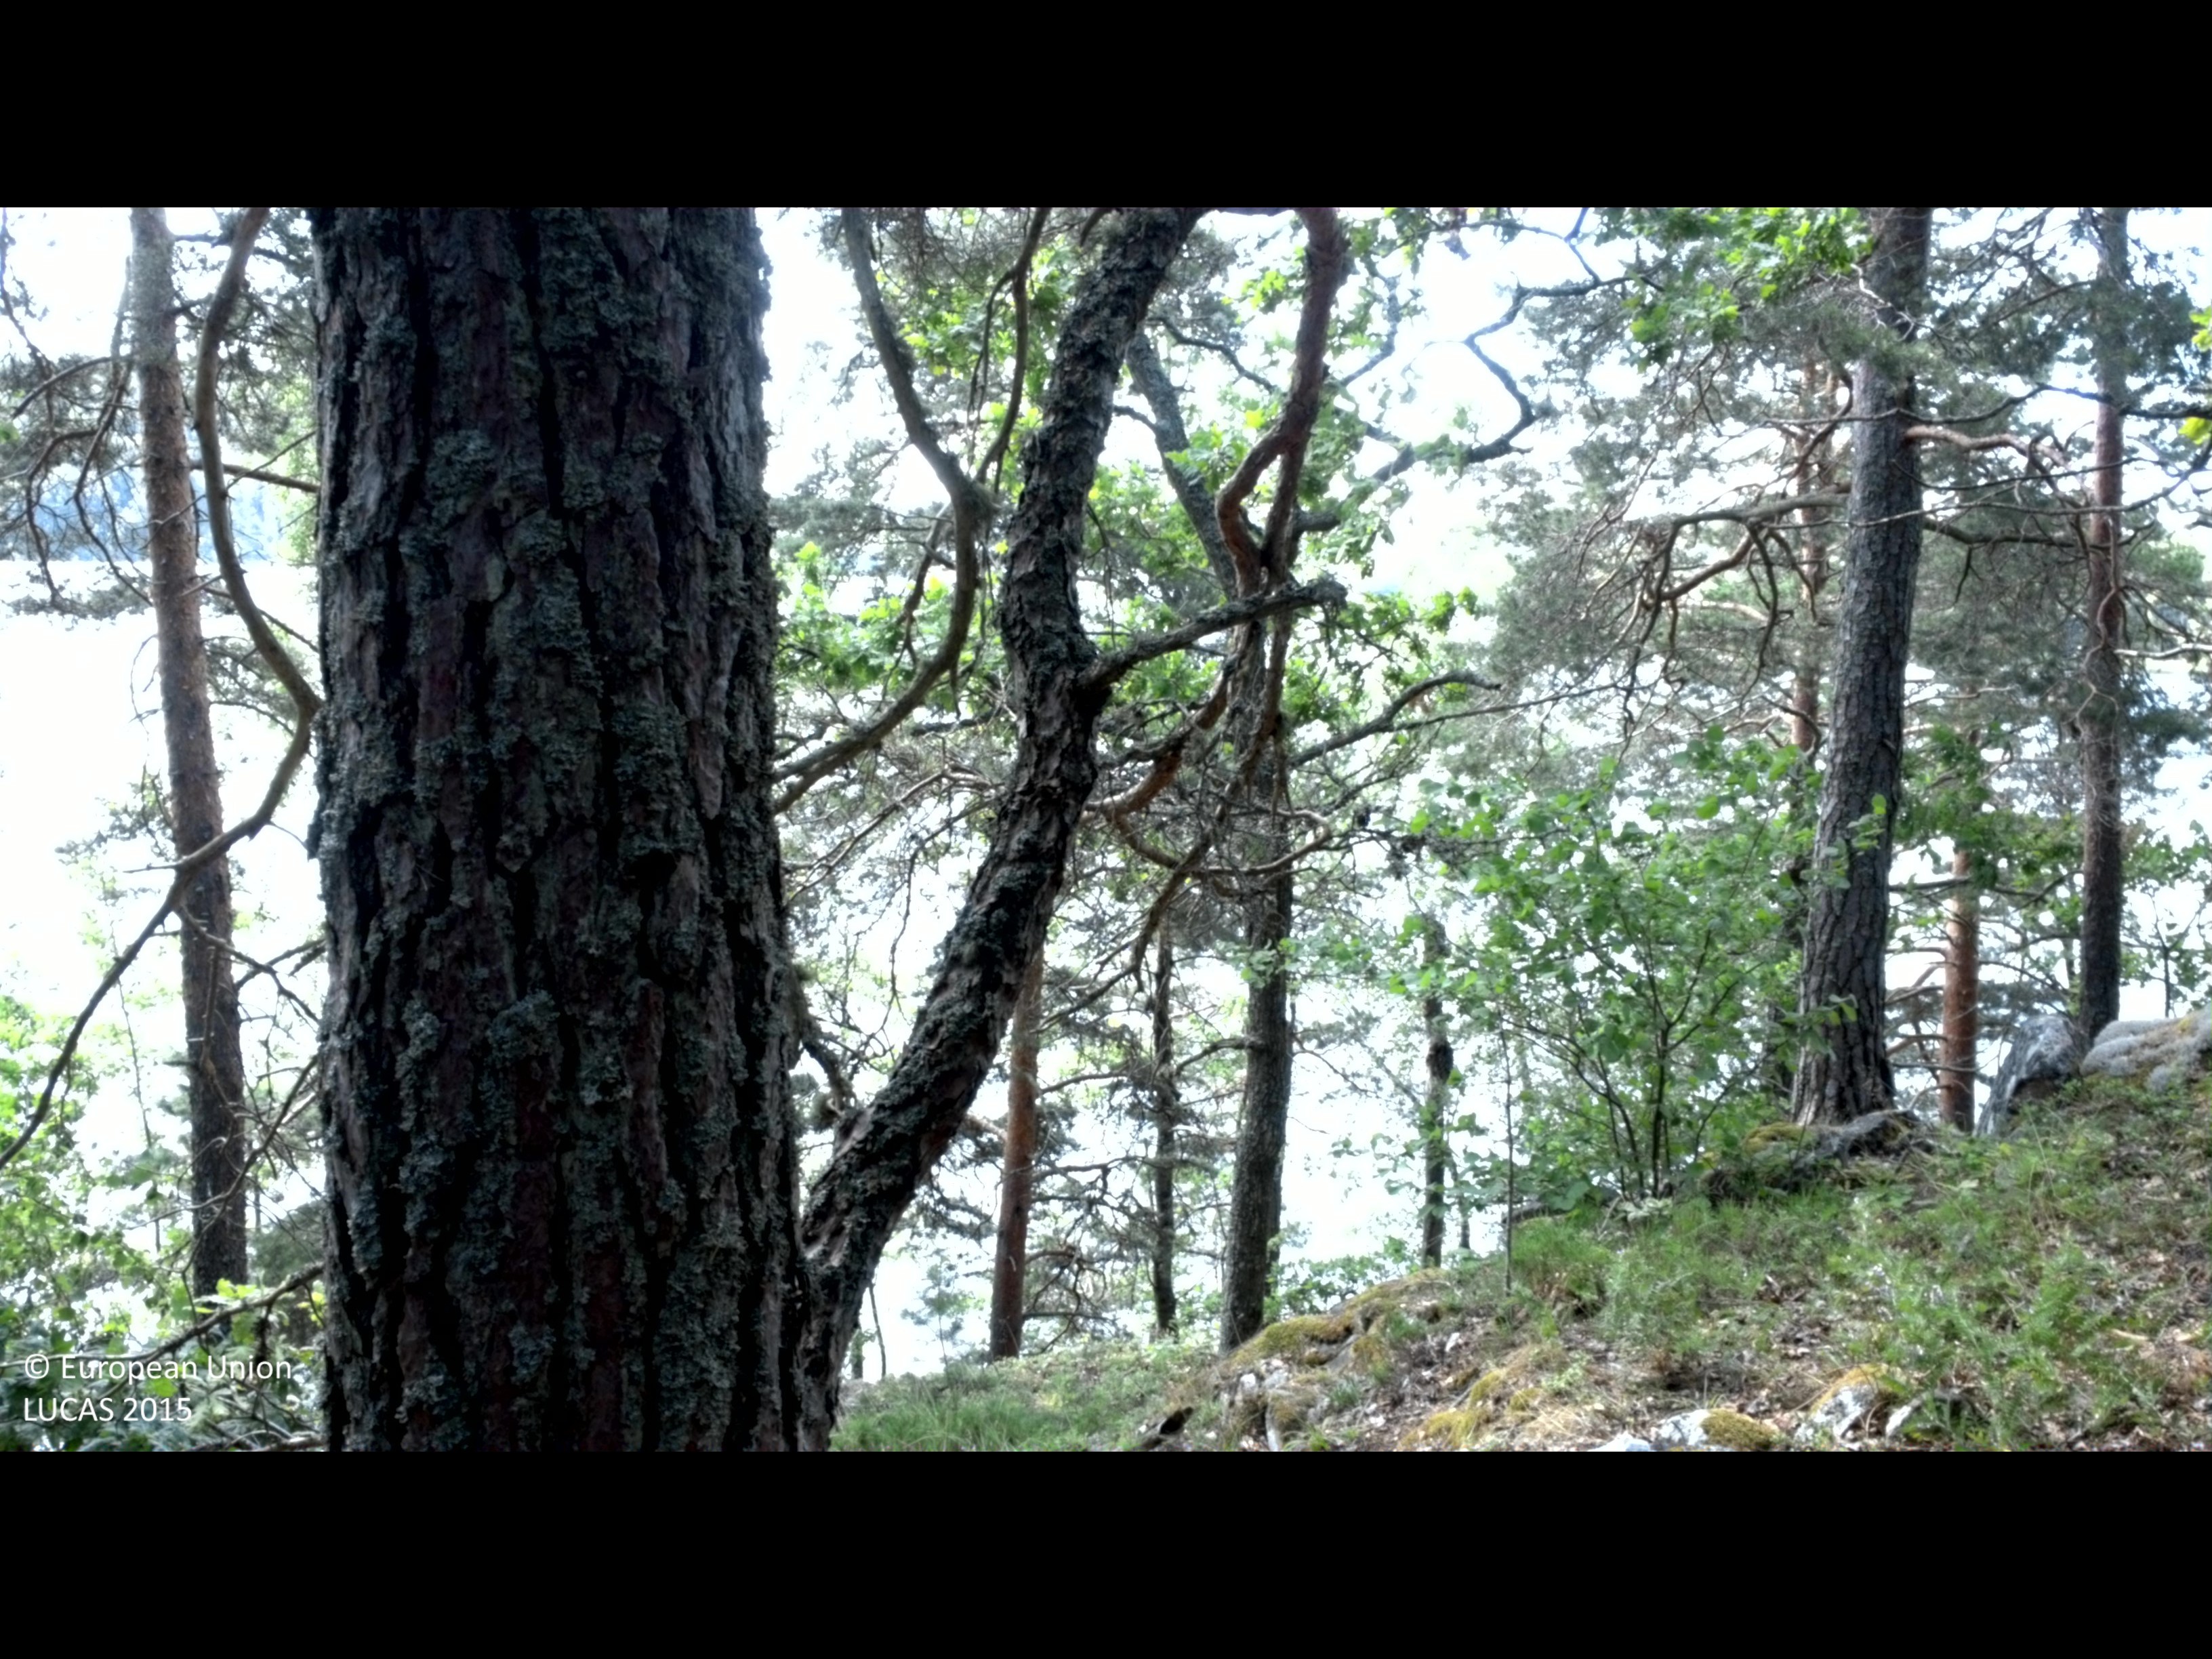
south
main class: Woodland
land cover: Pine dominated mixed woodland
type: boreal forest
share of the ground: 50 - 75 %
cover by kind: coniferous forest trees 40 %, broadleaved forest trees 30 %, shrubs 15 %, lichens and mosses 10 %, herbaceous plants 5 %
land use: Forestry
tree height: > 5 m
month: July
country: SE
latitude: 58.2662
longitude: 16.3888
